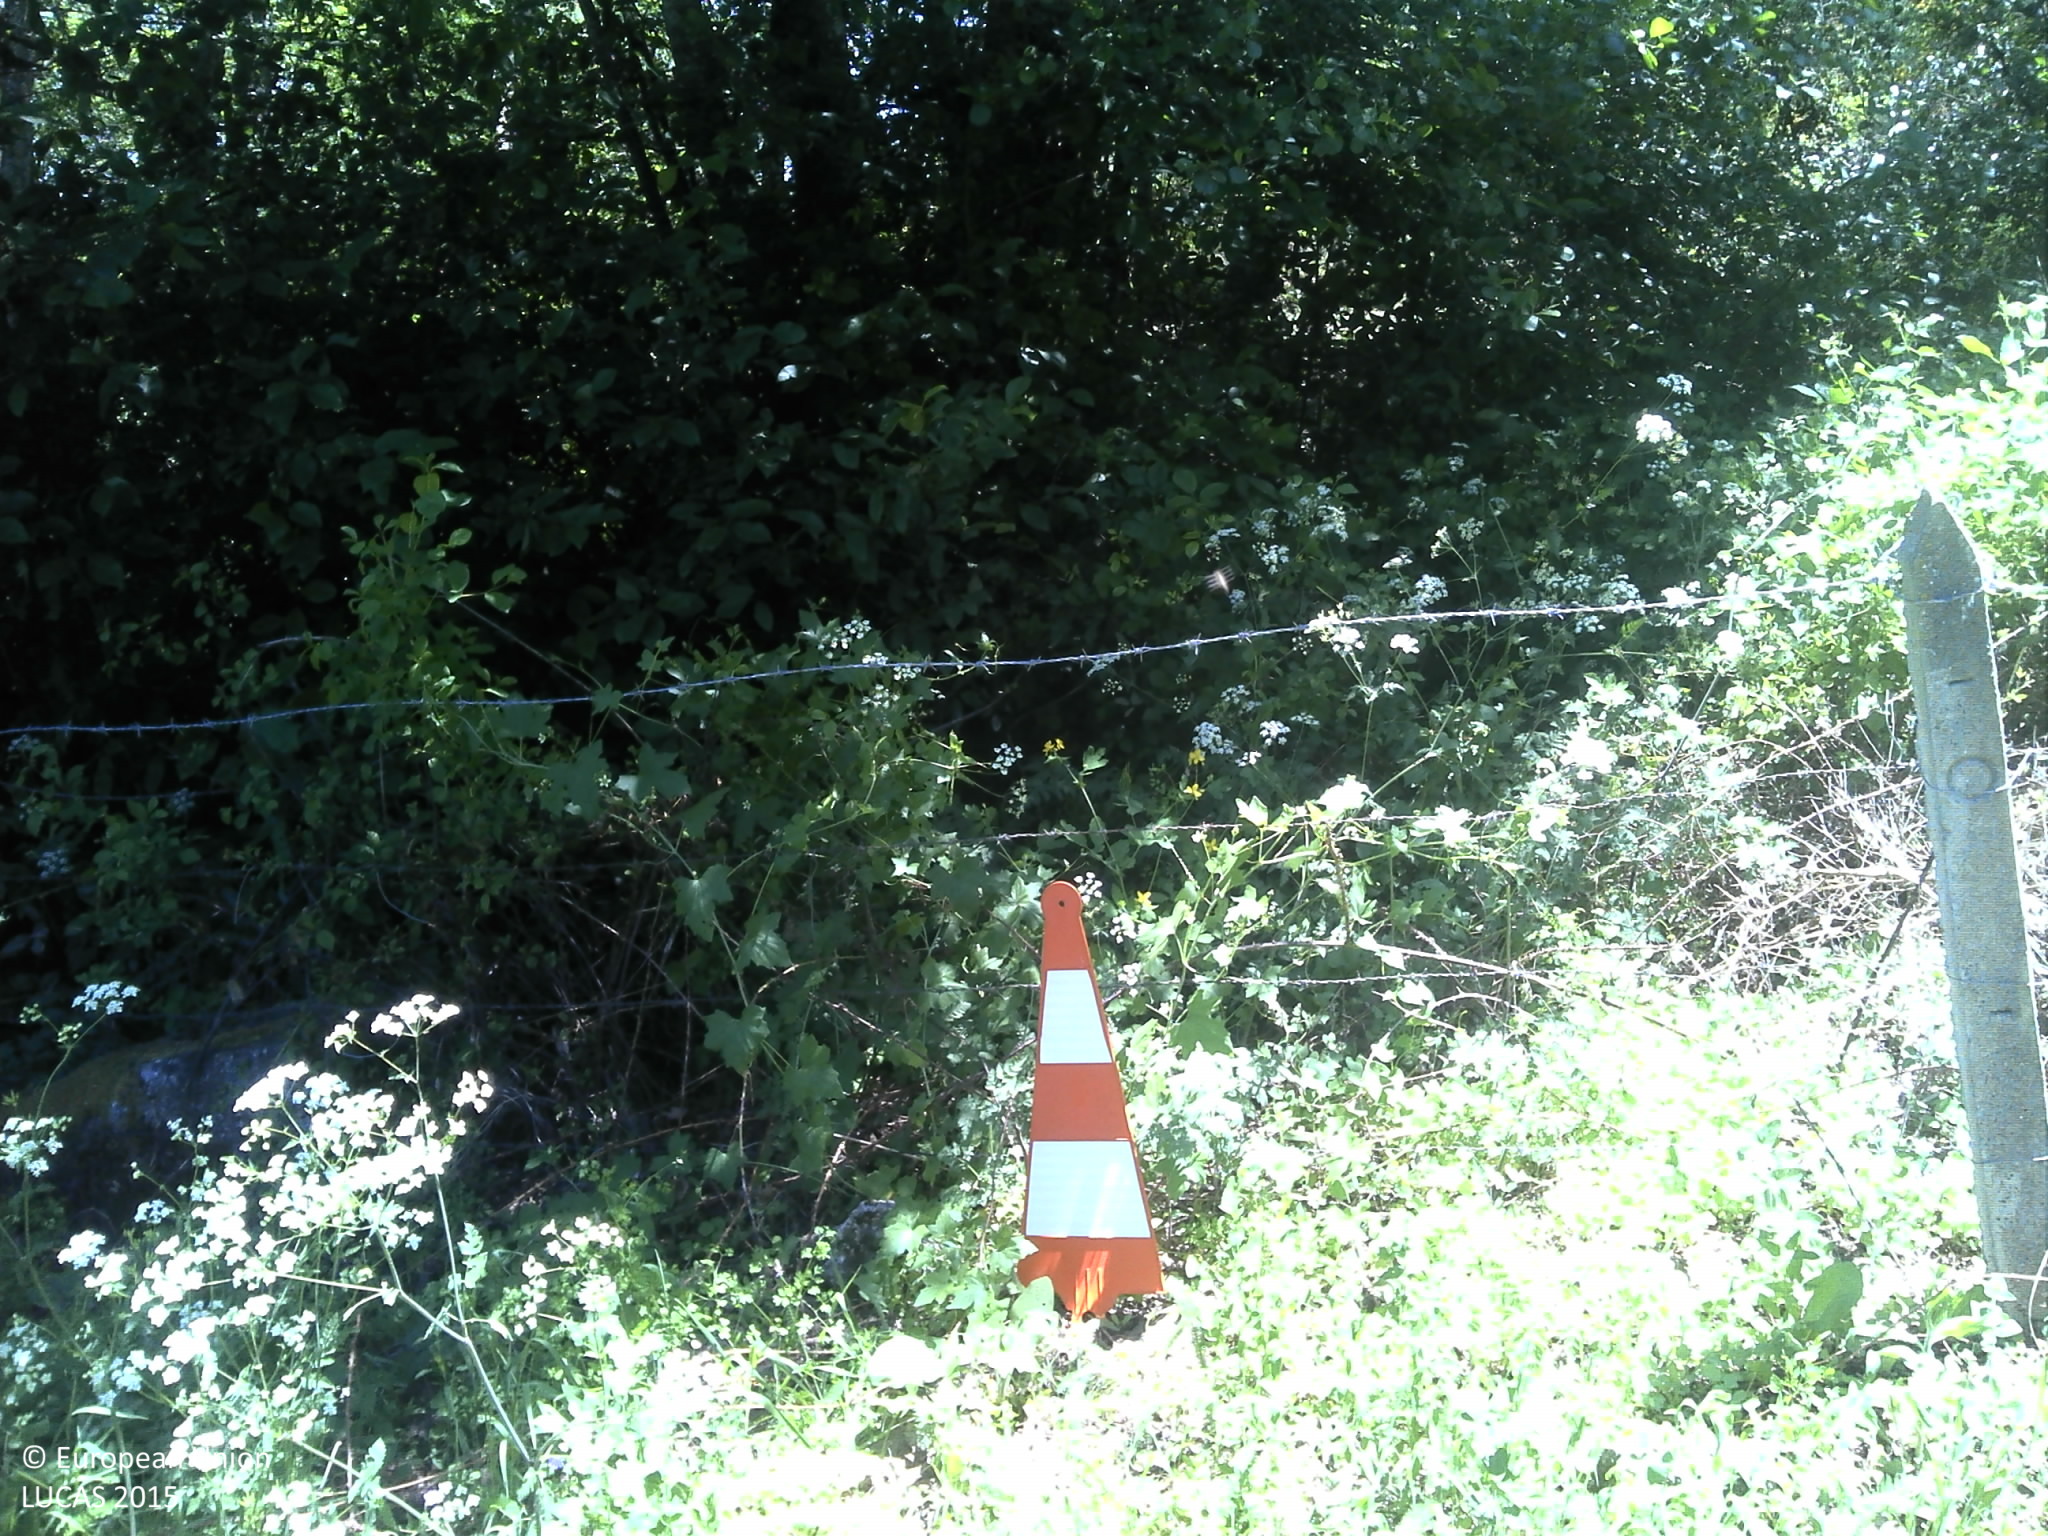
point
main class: Grassland
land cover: Grassland without tree/shrub cover
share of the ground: 50 - 75 %
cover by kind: herbaceous plants 65 %, consolidated bare surface 15 %, unconsolidated bare surface 15 %
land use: Agriculture (excluding fallow land and kitchen gardens)
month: May
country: PT
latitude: 40.5149
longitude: -7.2540
